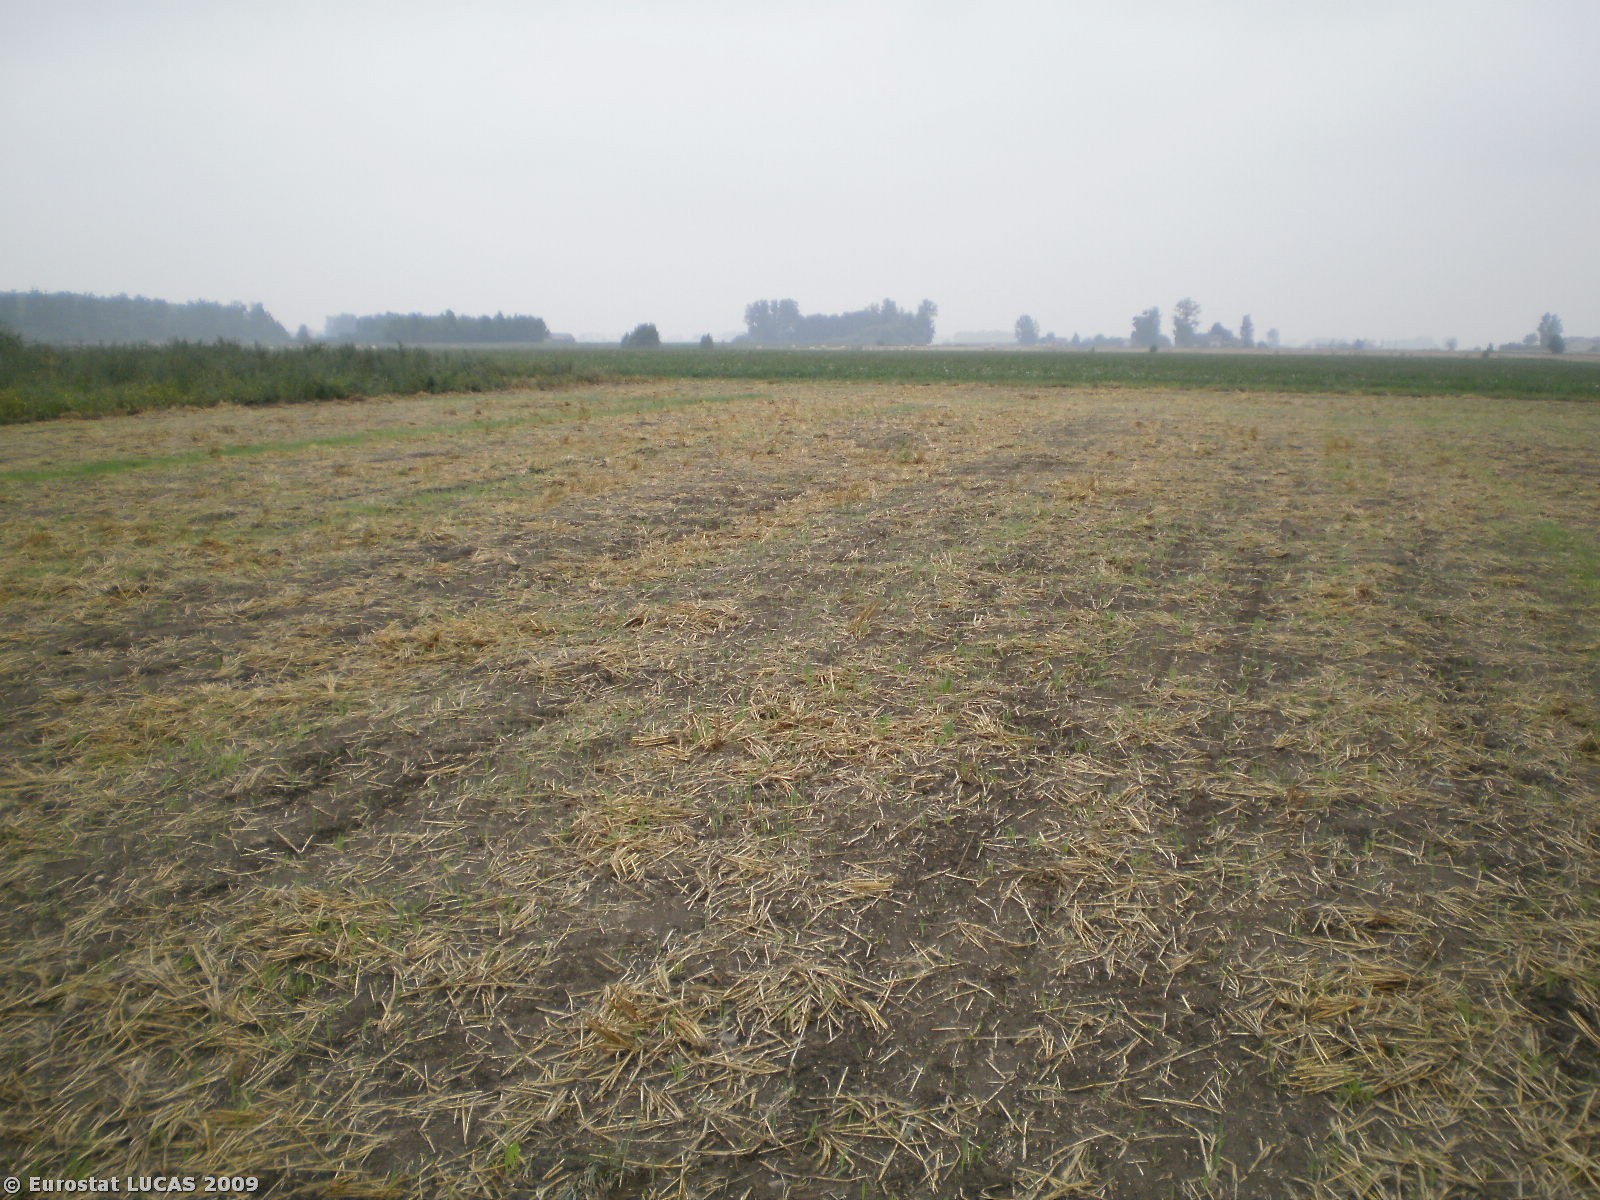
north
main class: Cropland
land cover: Barley
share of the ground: < 10 %
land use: Agriculture (excluding fallow land and kitchen gardens)
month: August
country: PL
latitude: 52.9277
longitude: 20.8869
